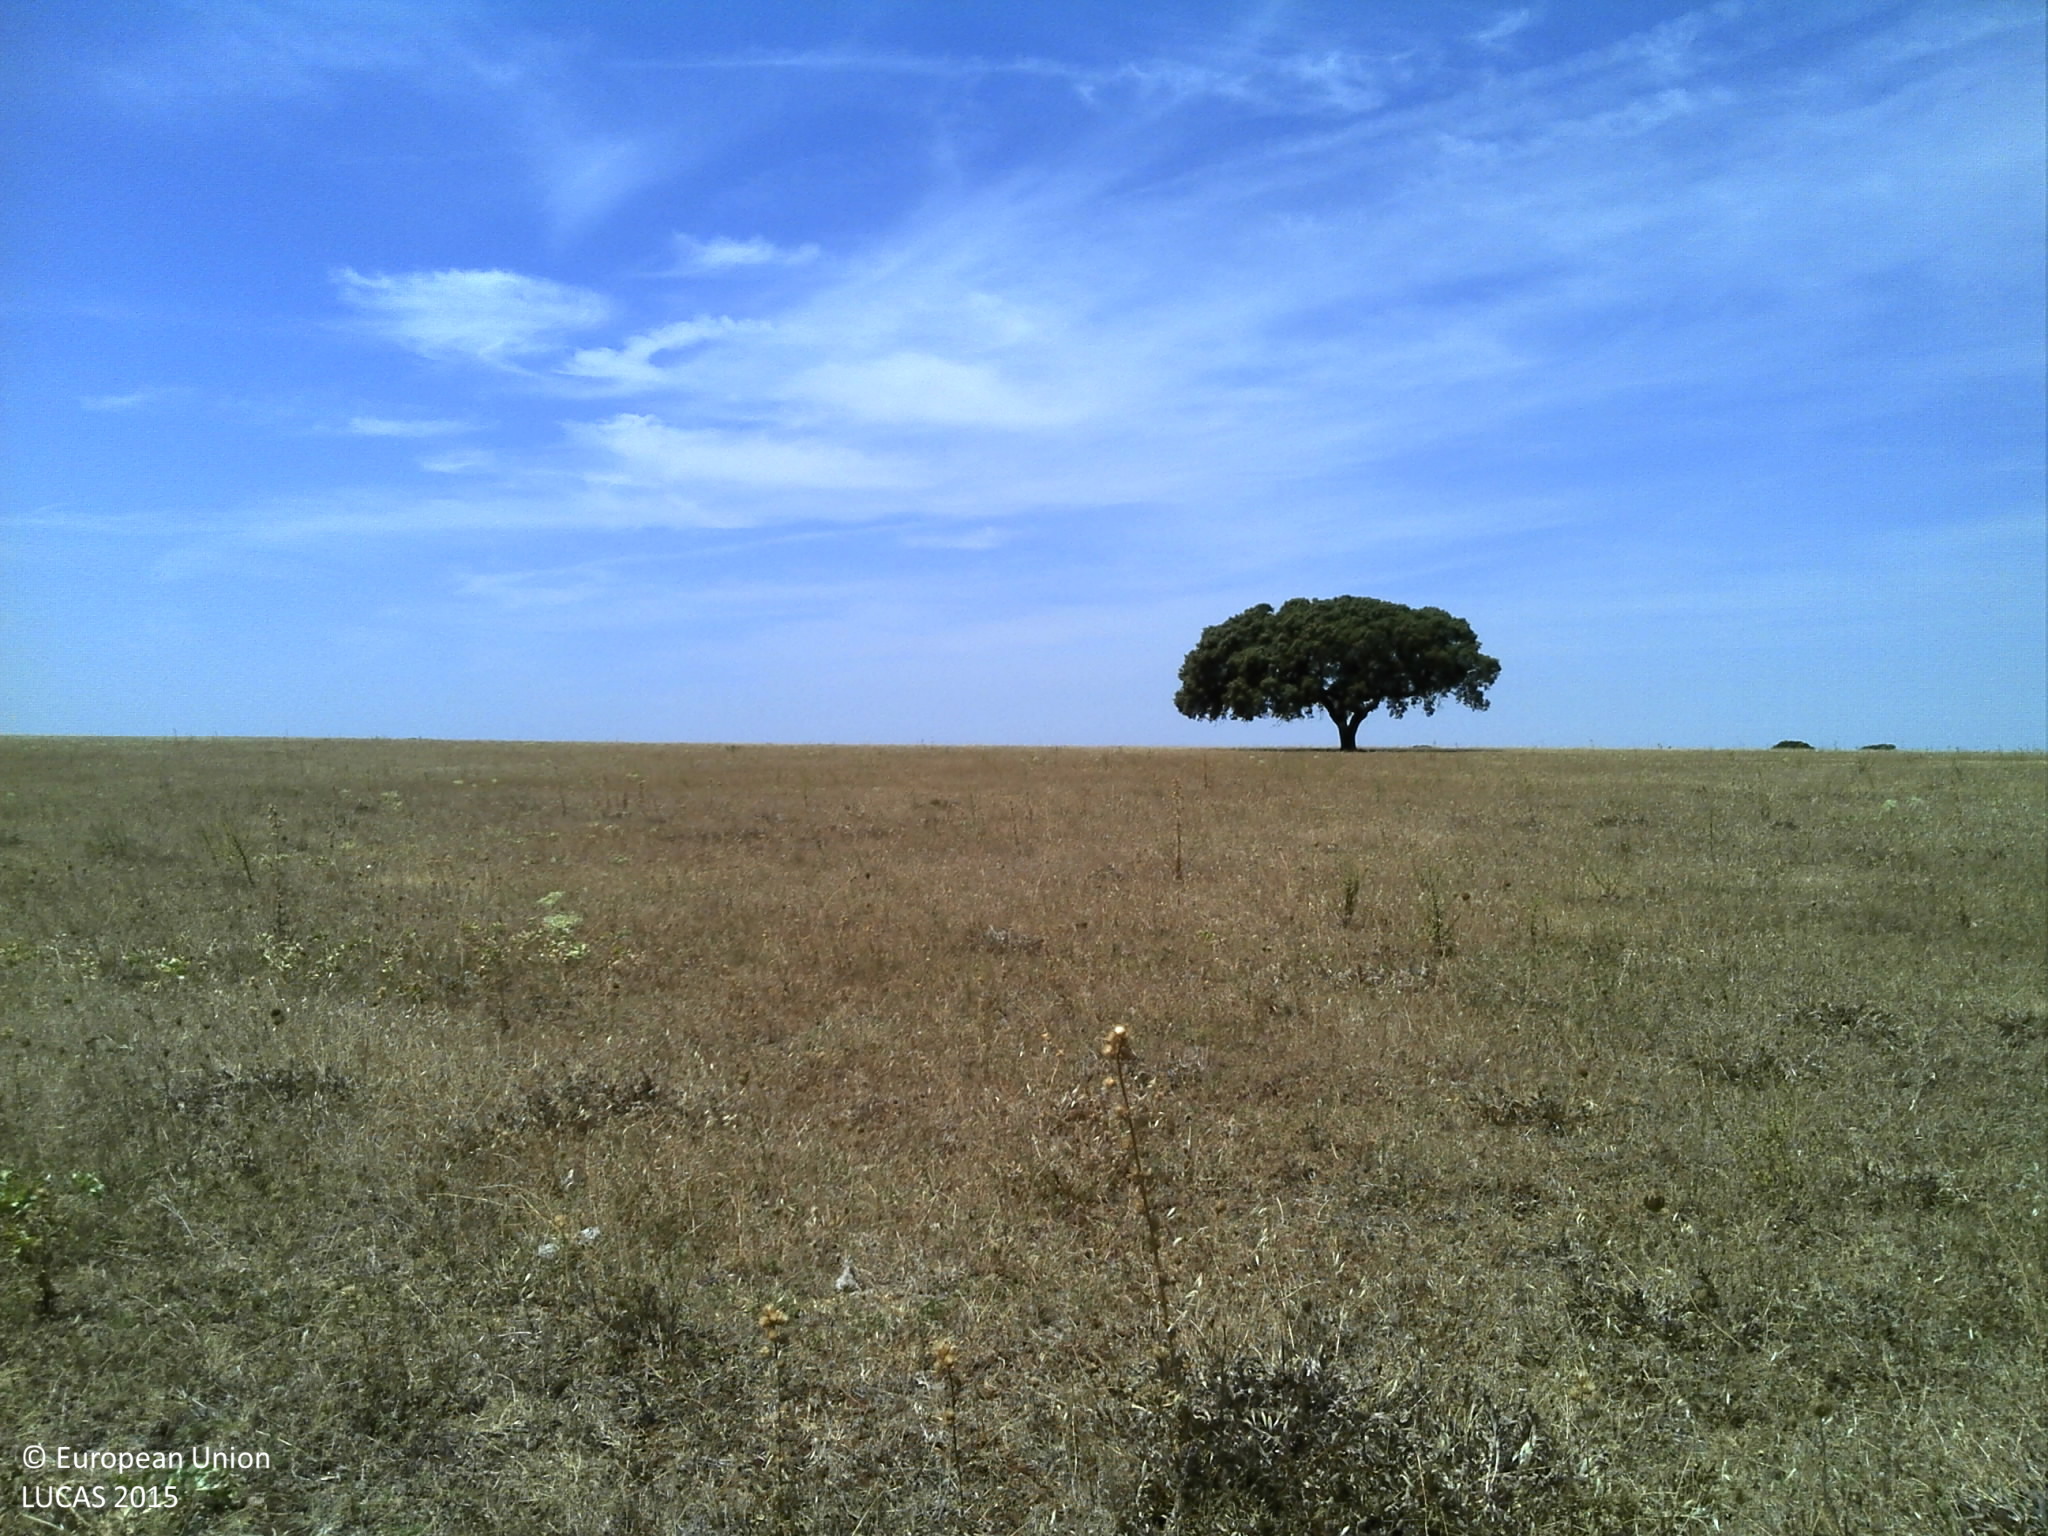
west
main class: Grassland
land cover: Spontaneously vegetated surfaces
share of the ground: 10 - 25 %
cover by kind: unconsolidated bare surface 85 %, herbaceous plants 15 %
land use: Agriculture (excluding fallow land and kitchen gardens)
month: July
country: PT
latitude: 38.4685
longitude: -7.6475
